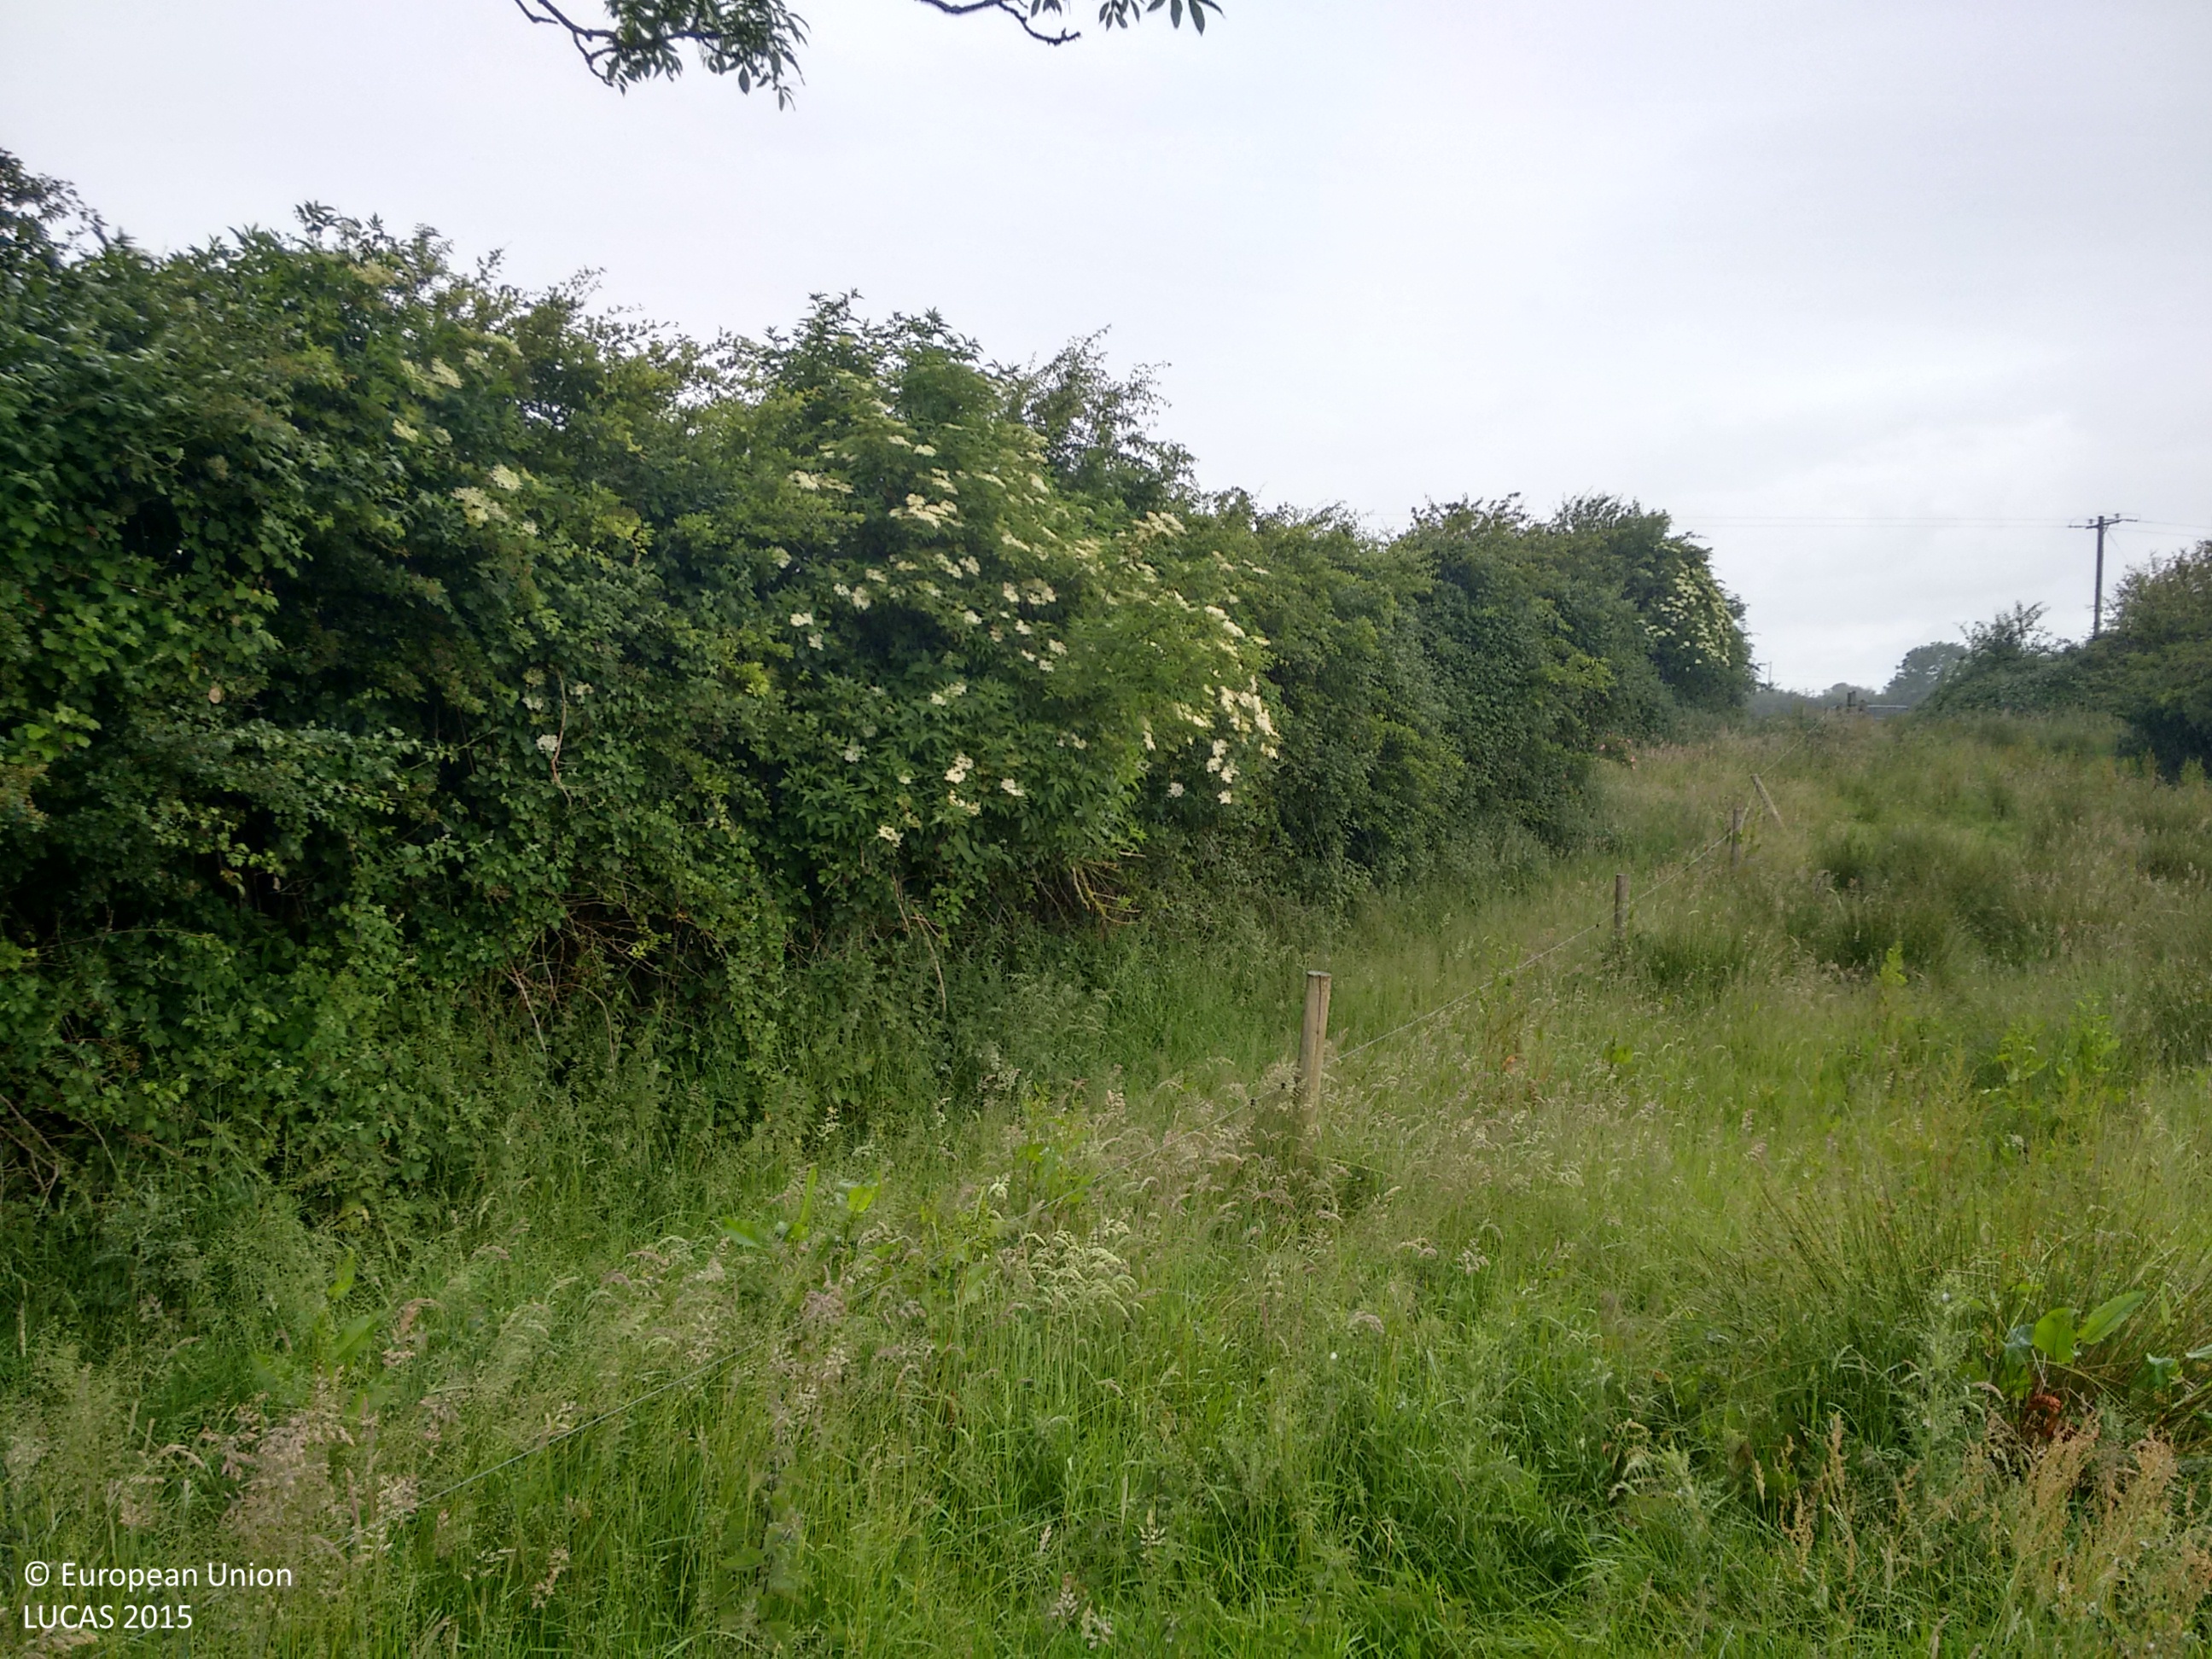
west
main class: Grassland
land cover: Grassland without tree/shrub cover
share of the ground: > 75 %
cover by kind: herbaceous plants 100 %
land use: Agriculture (excluding fallow land and kitchen gardens)
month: July
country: IE
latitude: 53.5888
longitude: -8.7071
